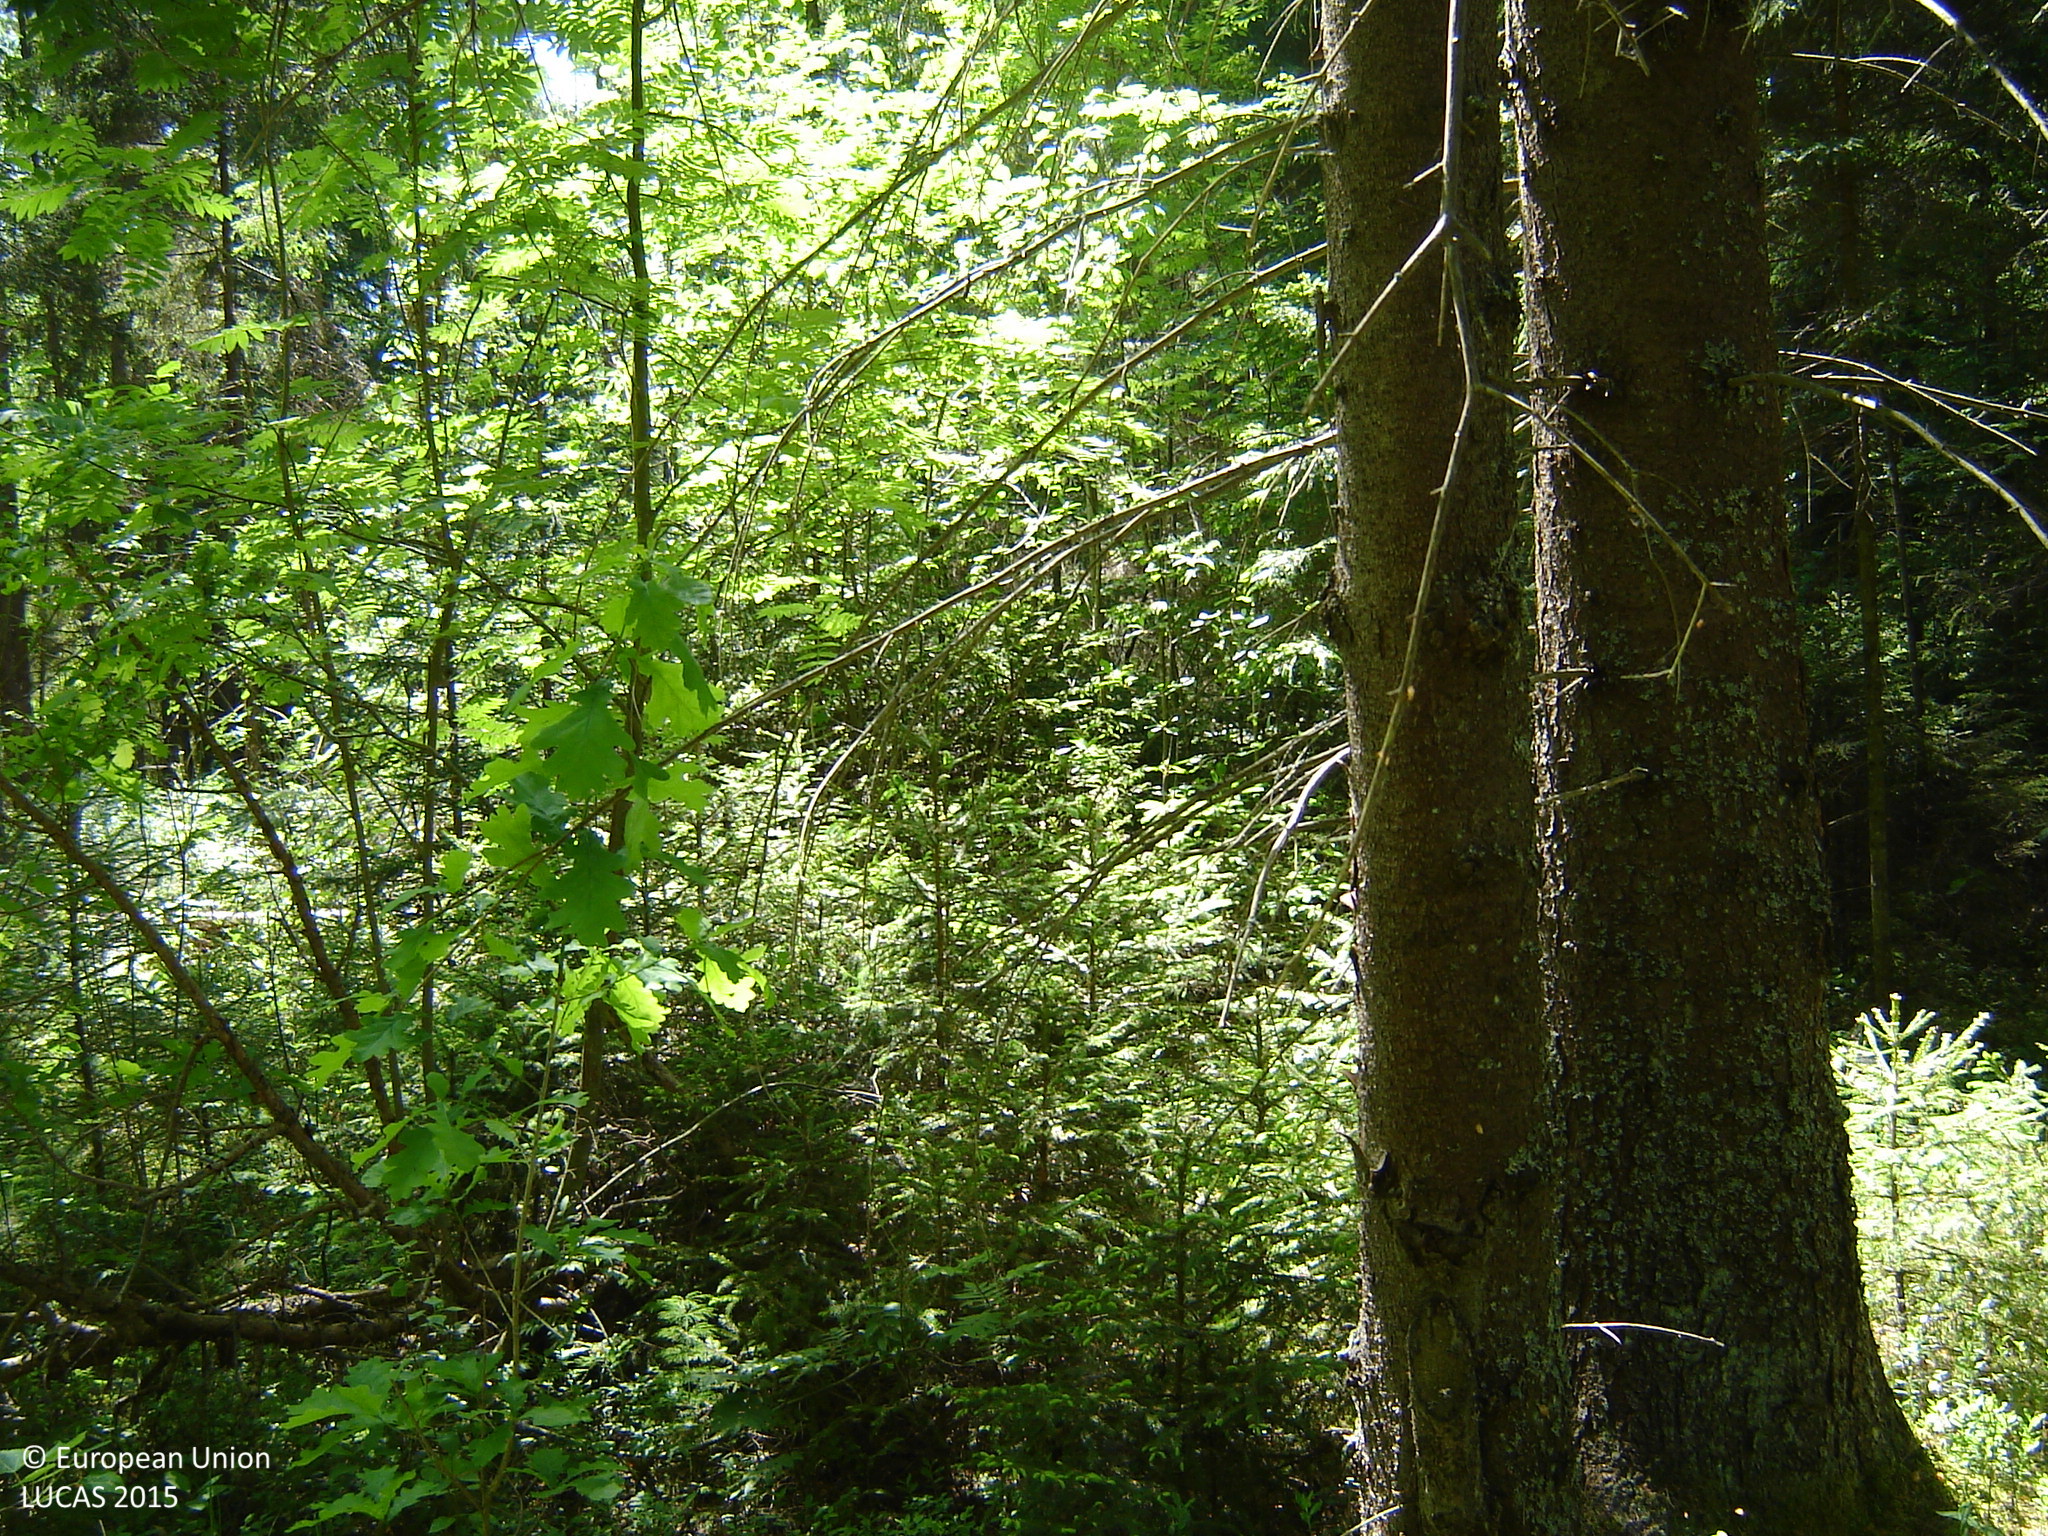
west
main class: Woodland
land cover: Spruce dominated coniferous woodland
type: hemiboreal forest and nemoral coniferous forest and mixed broadleaved-coniferous forest
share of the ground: > 75 %
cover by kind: coniferous forest trees 80 %, broadleaved forest trees 10 %, herbaceous plants 10 %
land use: Forestry
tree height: > 5 m
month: June
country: LT
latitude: 55.5932
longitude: 25.1422
